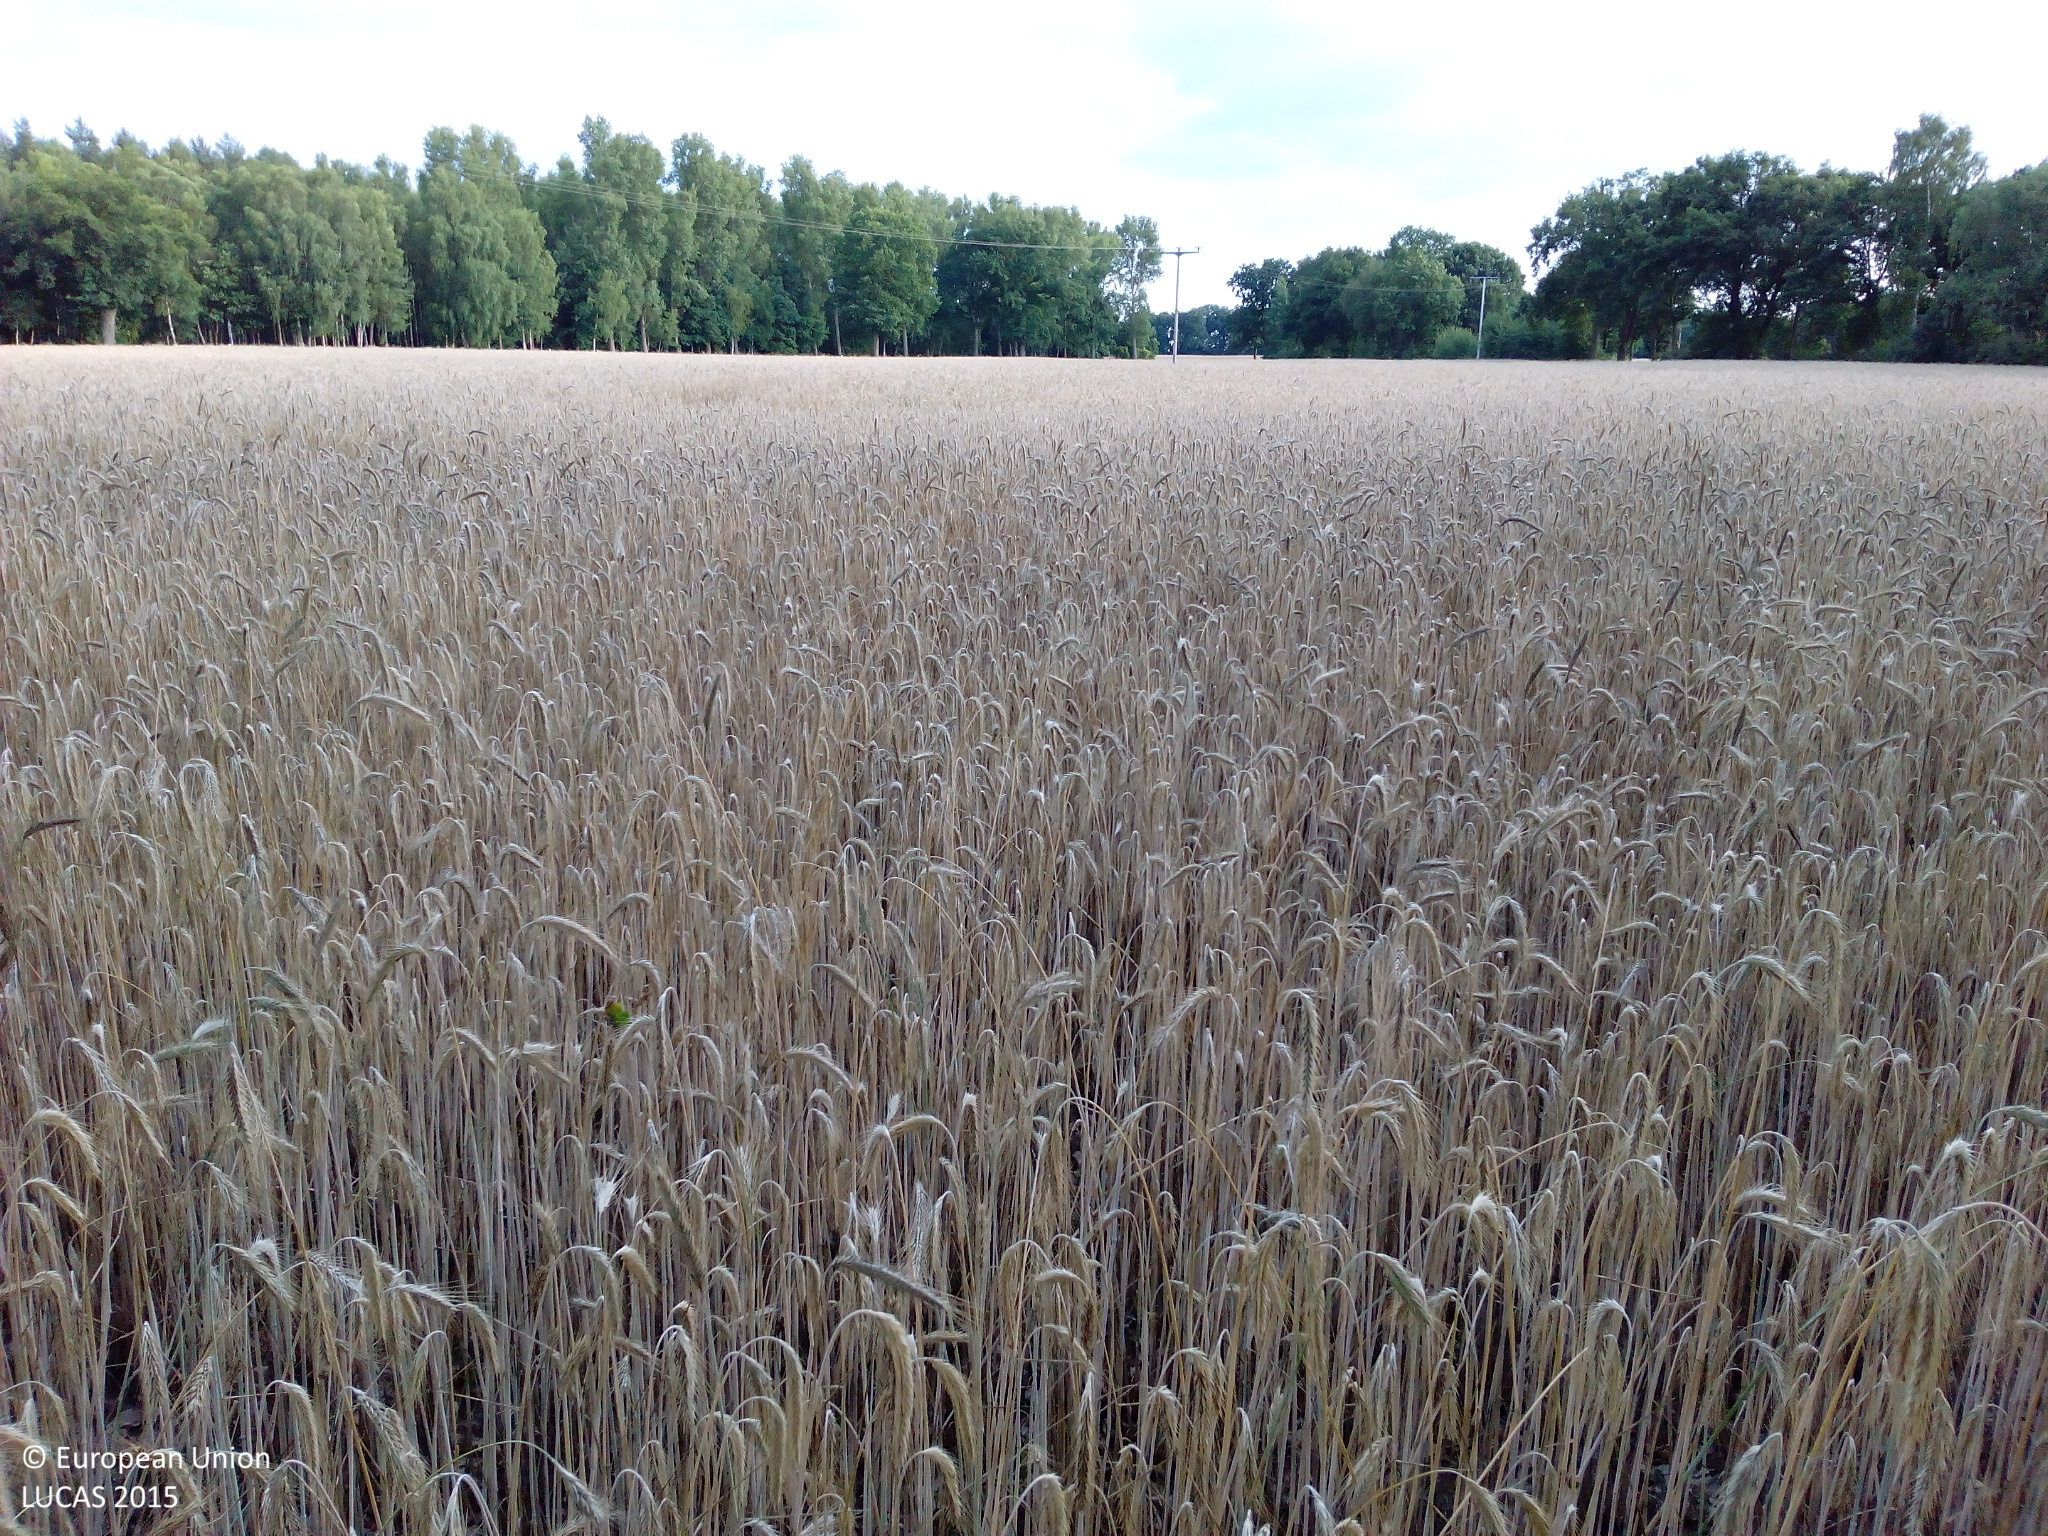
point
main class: Cropland
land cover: Rye
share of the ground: > 75 %
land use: Agriculture (excluding fallow land and kitchen gardens)
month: July
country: DE
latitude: 52.9641
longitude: 12.4262
